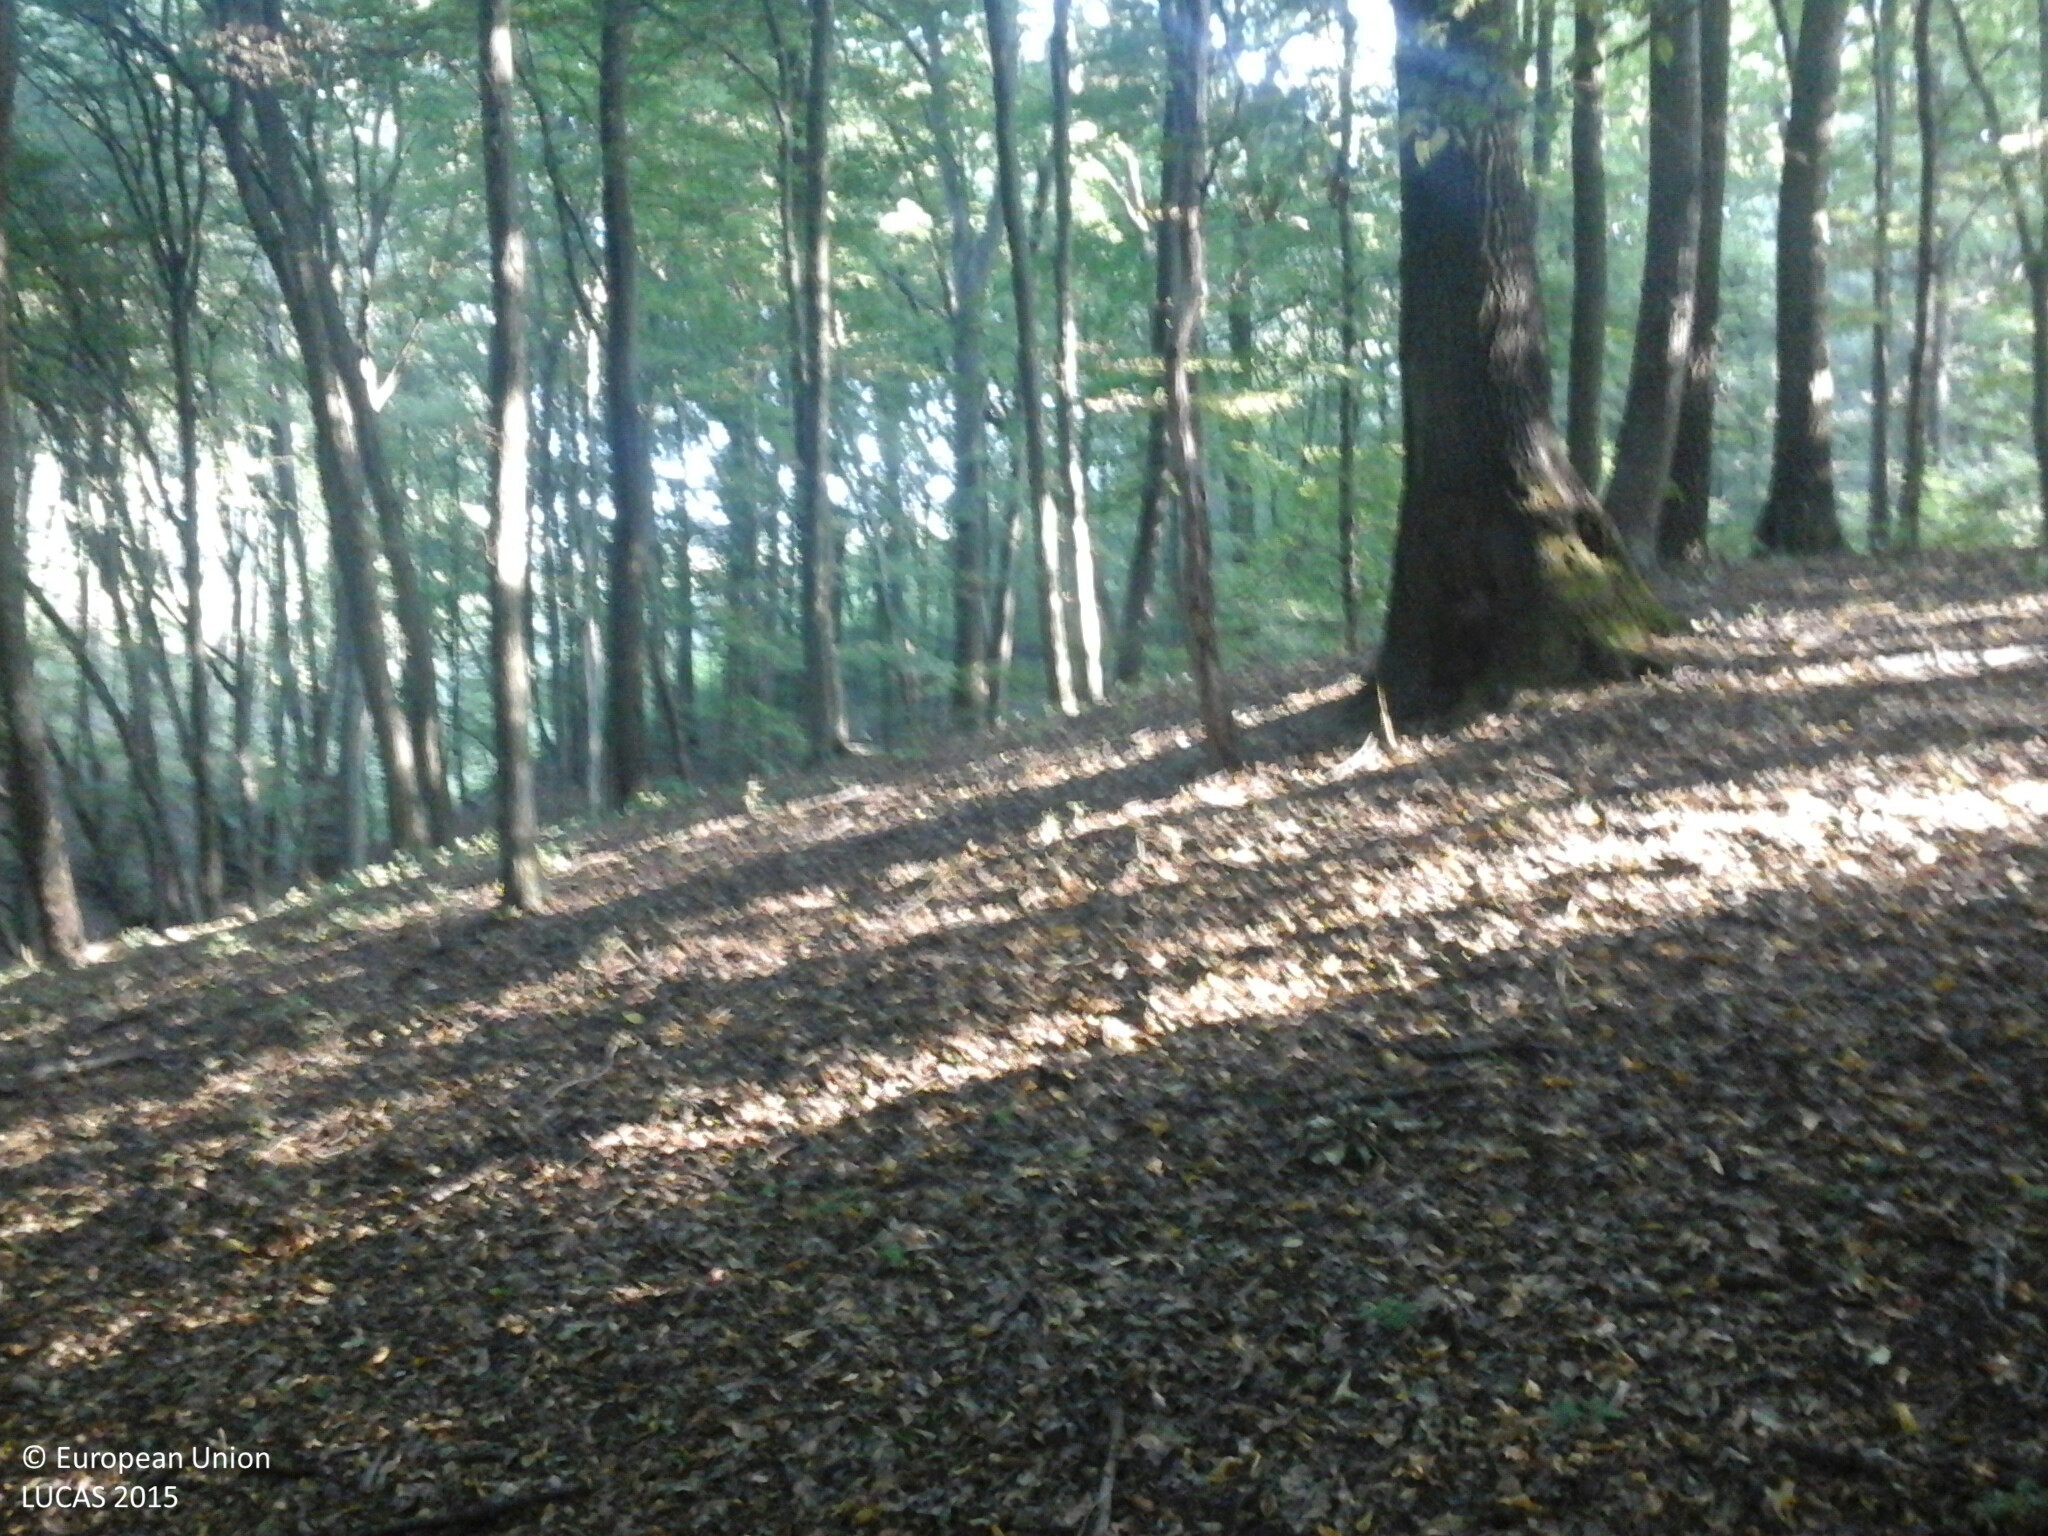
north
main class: Woodland
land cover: Broadleaved woodland
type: mesophytic deciduous forest
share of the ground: > 75 %
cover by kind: broadleaved forest trees 95 %, herbaceous plants 5 %
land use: Forestry
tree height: > 5 m
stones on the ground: < 10 %
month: August
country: HU
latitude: 47.5032
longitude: 18.4170
